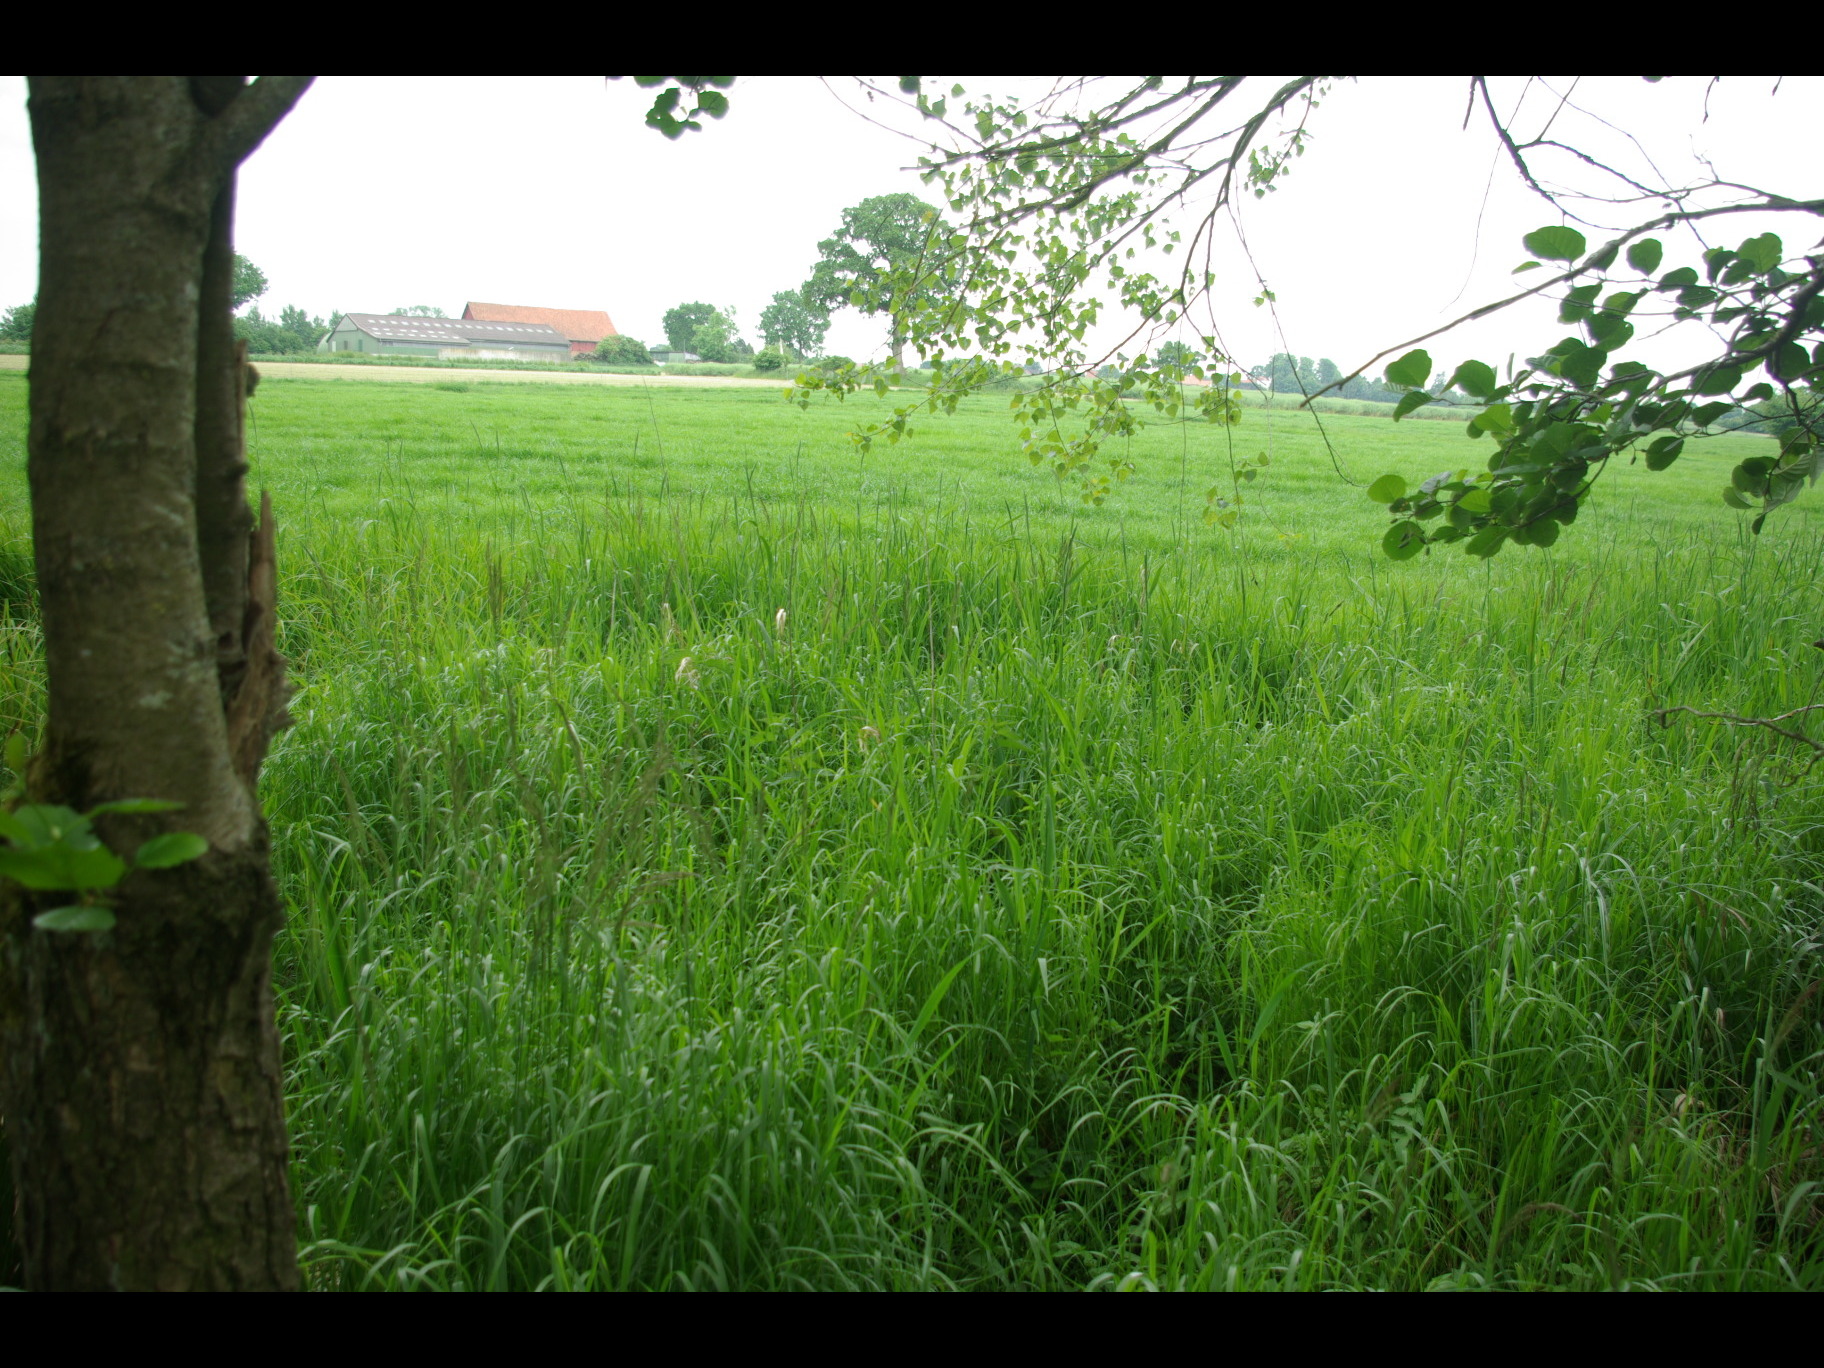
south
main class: Woodland
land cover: Broadleaved woodland
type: mire and swamp forests
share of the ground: 50 - 75 %
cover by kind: broadleaved forest trees 50 %, herbaceous plants 45 %, shrubs 5 %
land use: Semi-natural and natural areas not in use
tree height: > 5 m
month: June
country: DE
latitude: 54.4263
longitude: 9.9230
